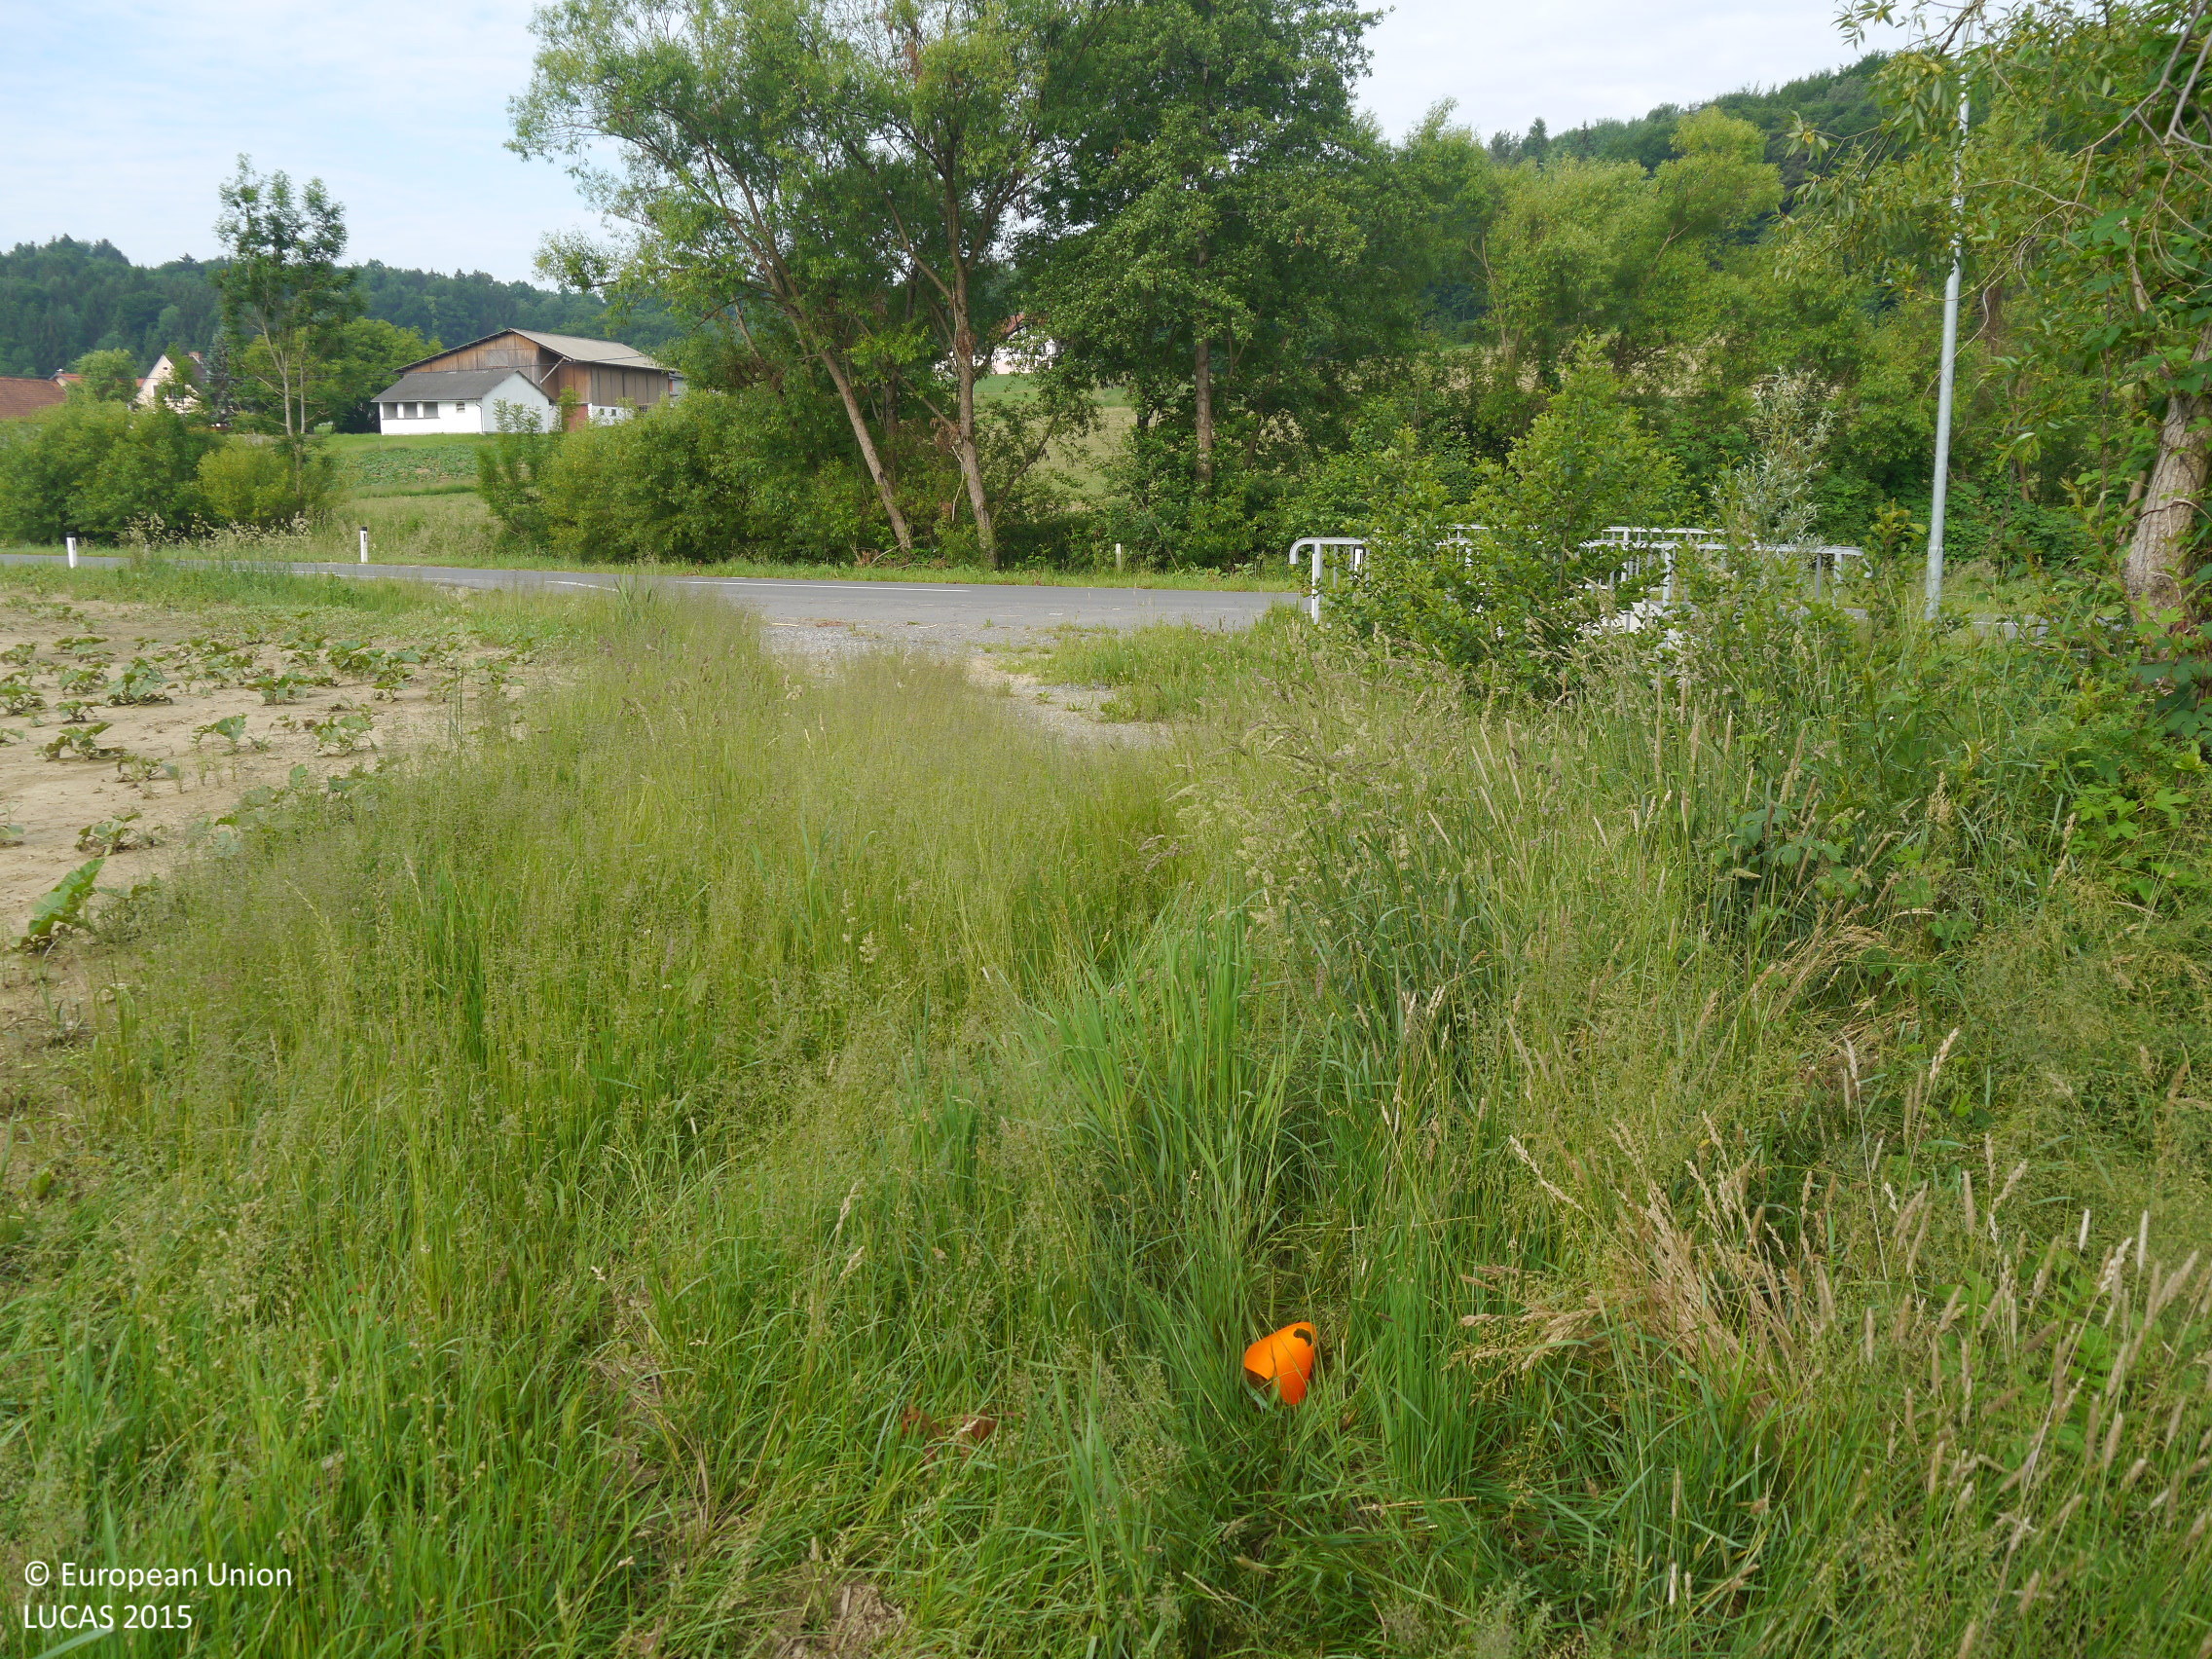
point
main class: Grassland
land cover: Grassland without tree/shrub cover
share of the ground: > 75 %
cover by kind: herbaceous plants 100 %
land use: Agriculture (excluding fallow land and kitchen gardens)
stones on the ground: < 10 %
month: June
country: AT
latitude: 46.9386
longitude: 15.7144
